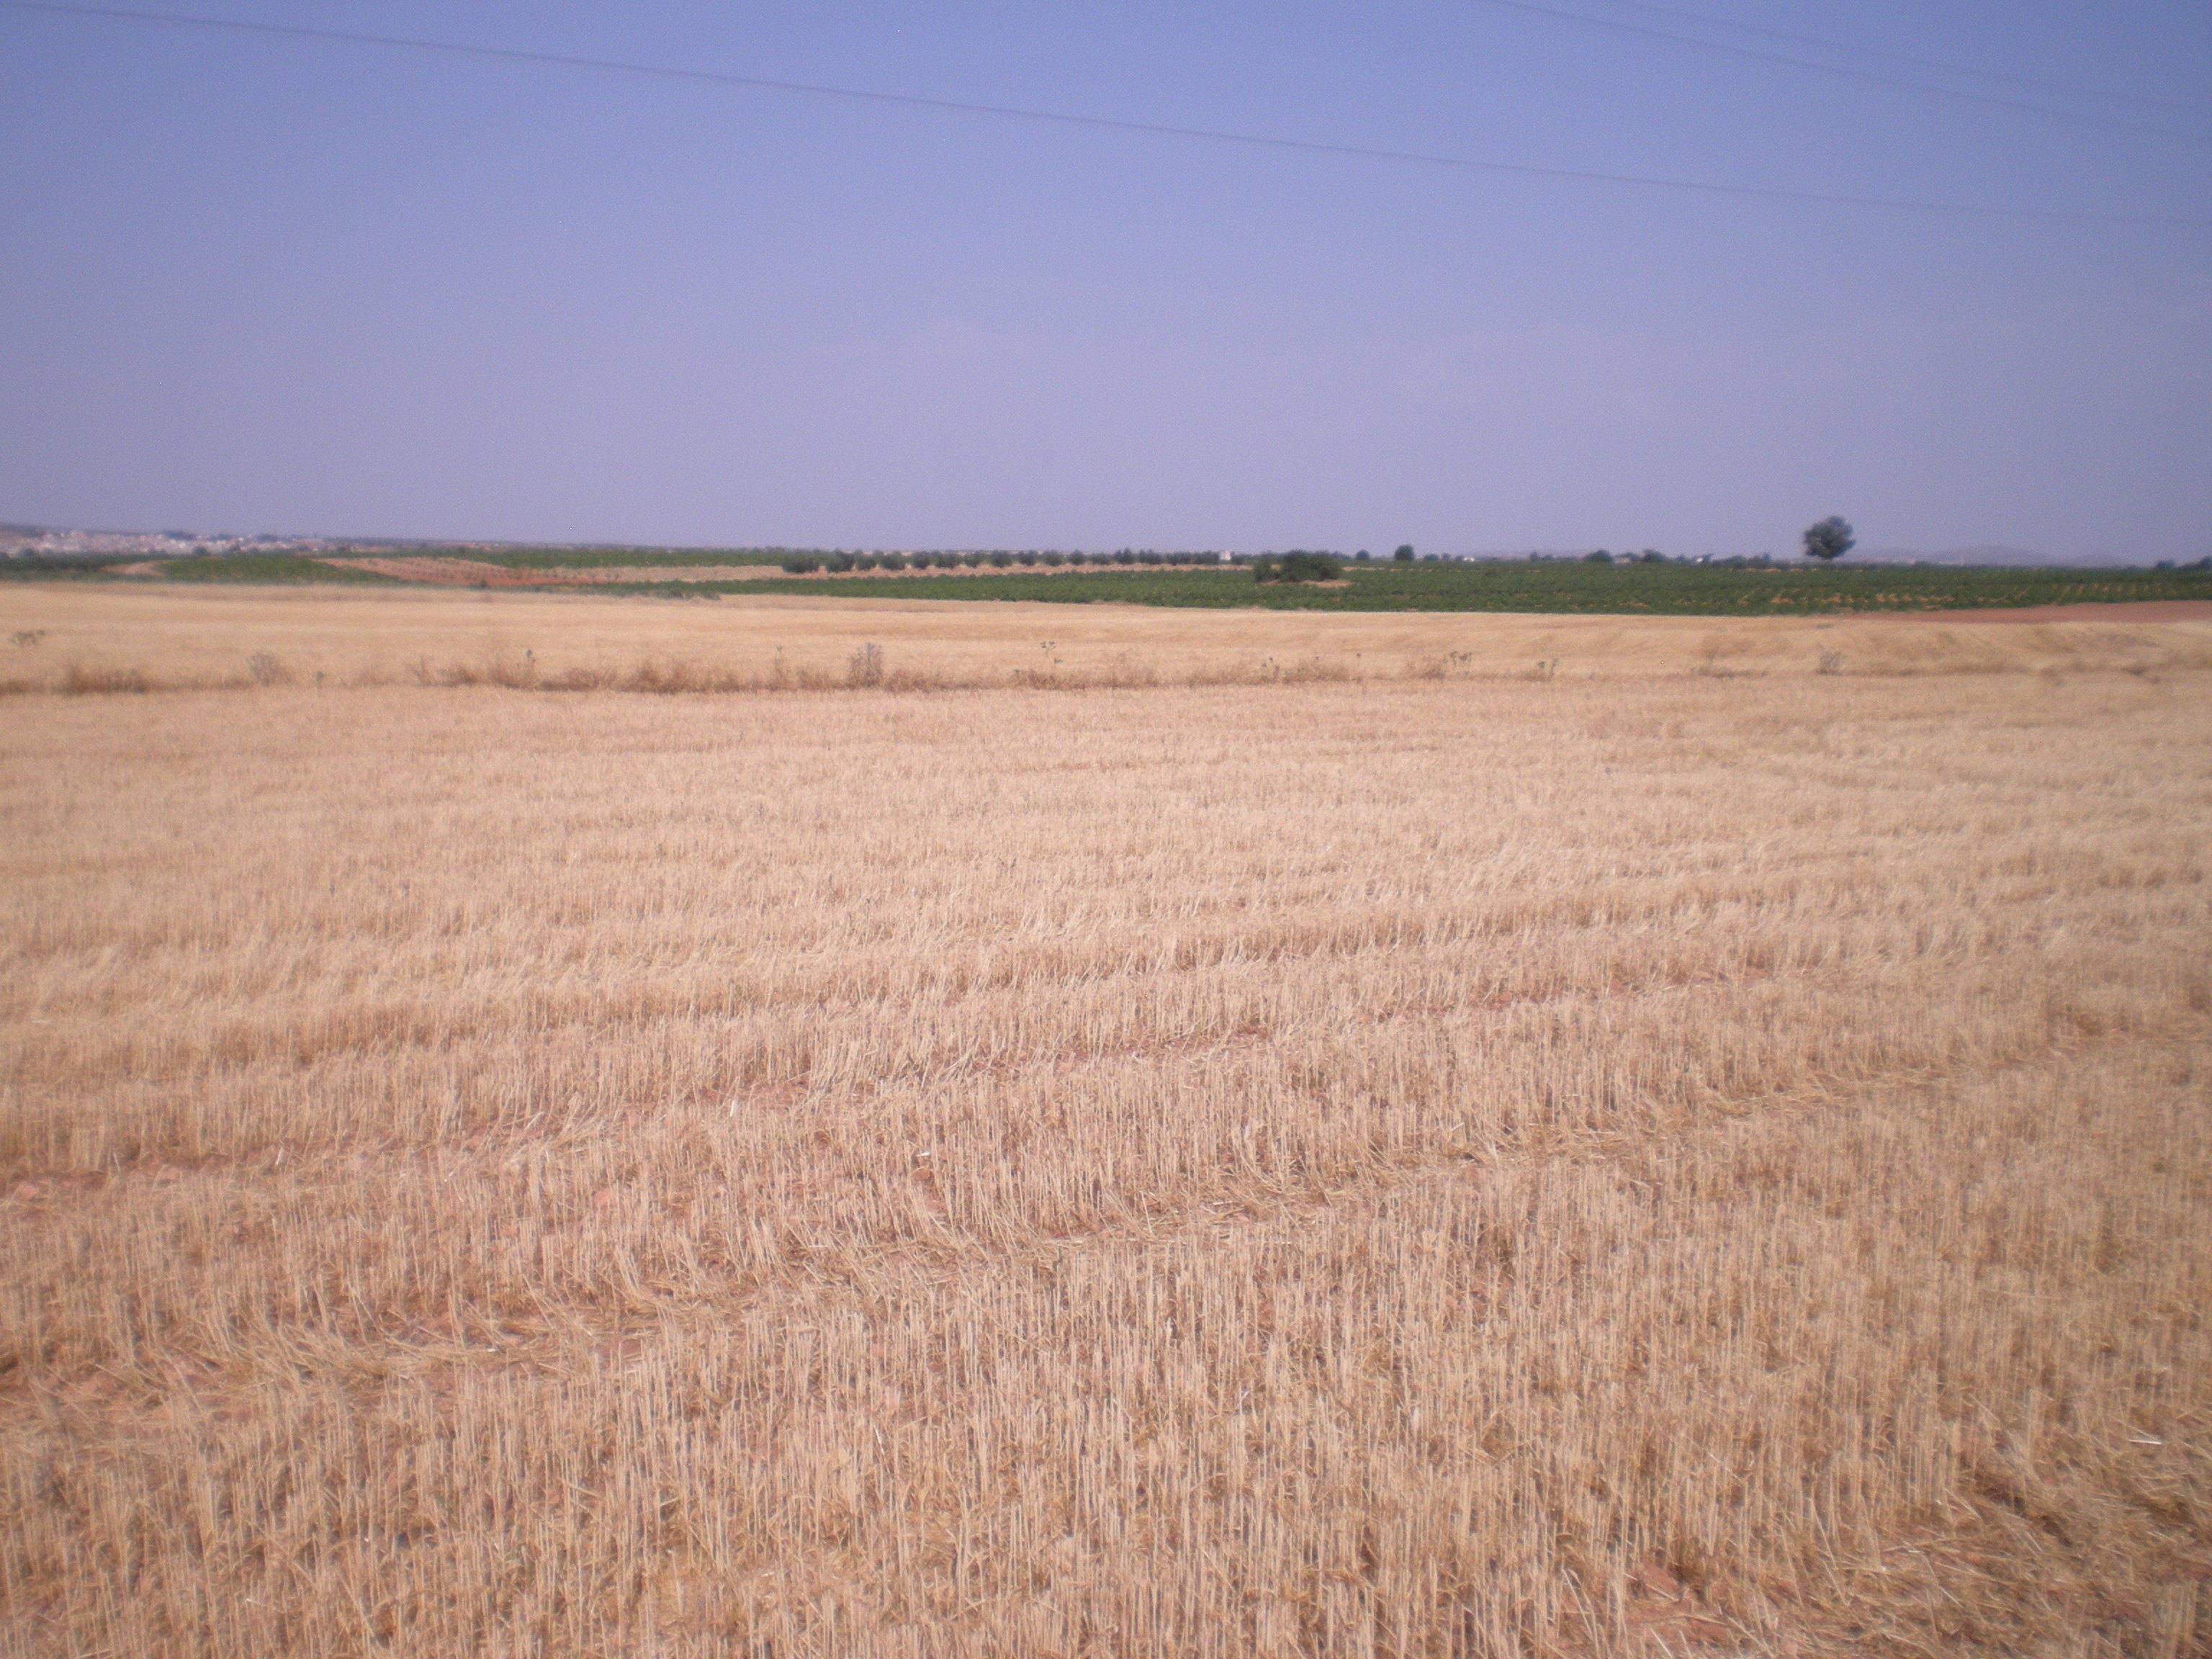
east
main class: Cropland
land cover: Common wheat
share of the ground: < 10 %
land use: Agriculture (excluding fallow land and kitchen gardens)
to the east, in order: Common wheat; Grass margins; Barley; Electric lines; Barley; Spontaneously vegetated surfaces
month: July
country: ES
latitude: 39.4201
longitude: -3.5074
